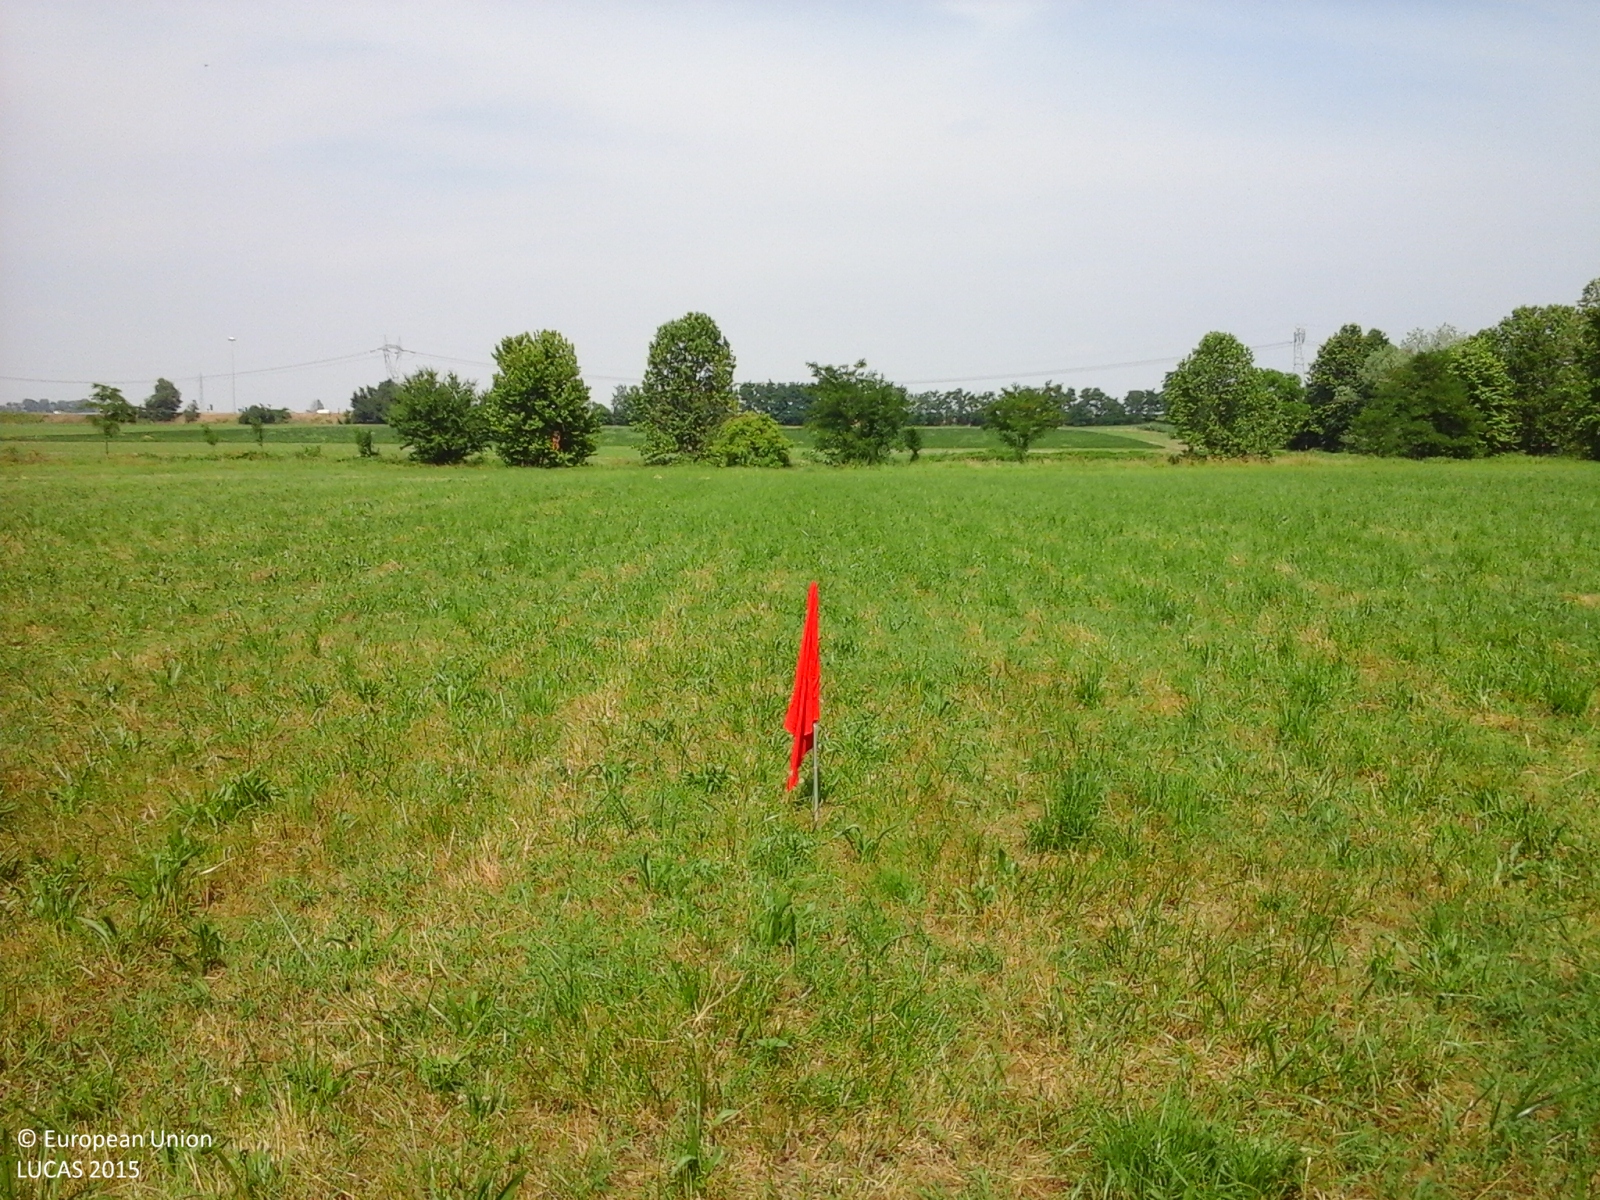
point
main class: Grassland
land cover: Grassland without tree/shrub cover
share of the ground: > 75 %
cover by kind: herbaceous plants 100 %
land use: Agriculture (excluding fallow land and kitchen gardens)
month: June
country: IT
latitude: 45.1614
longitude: 9.6572
